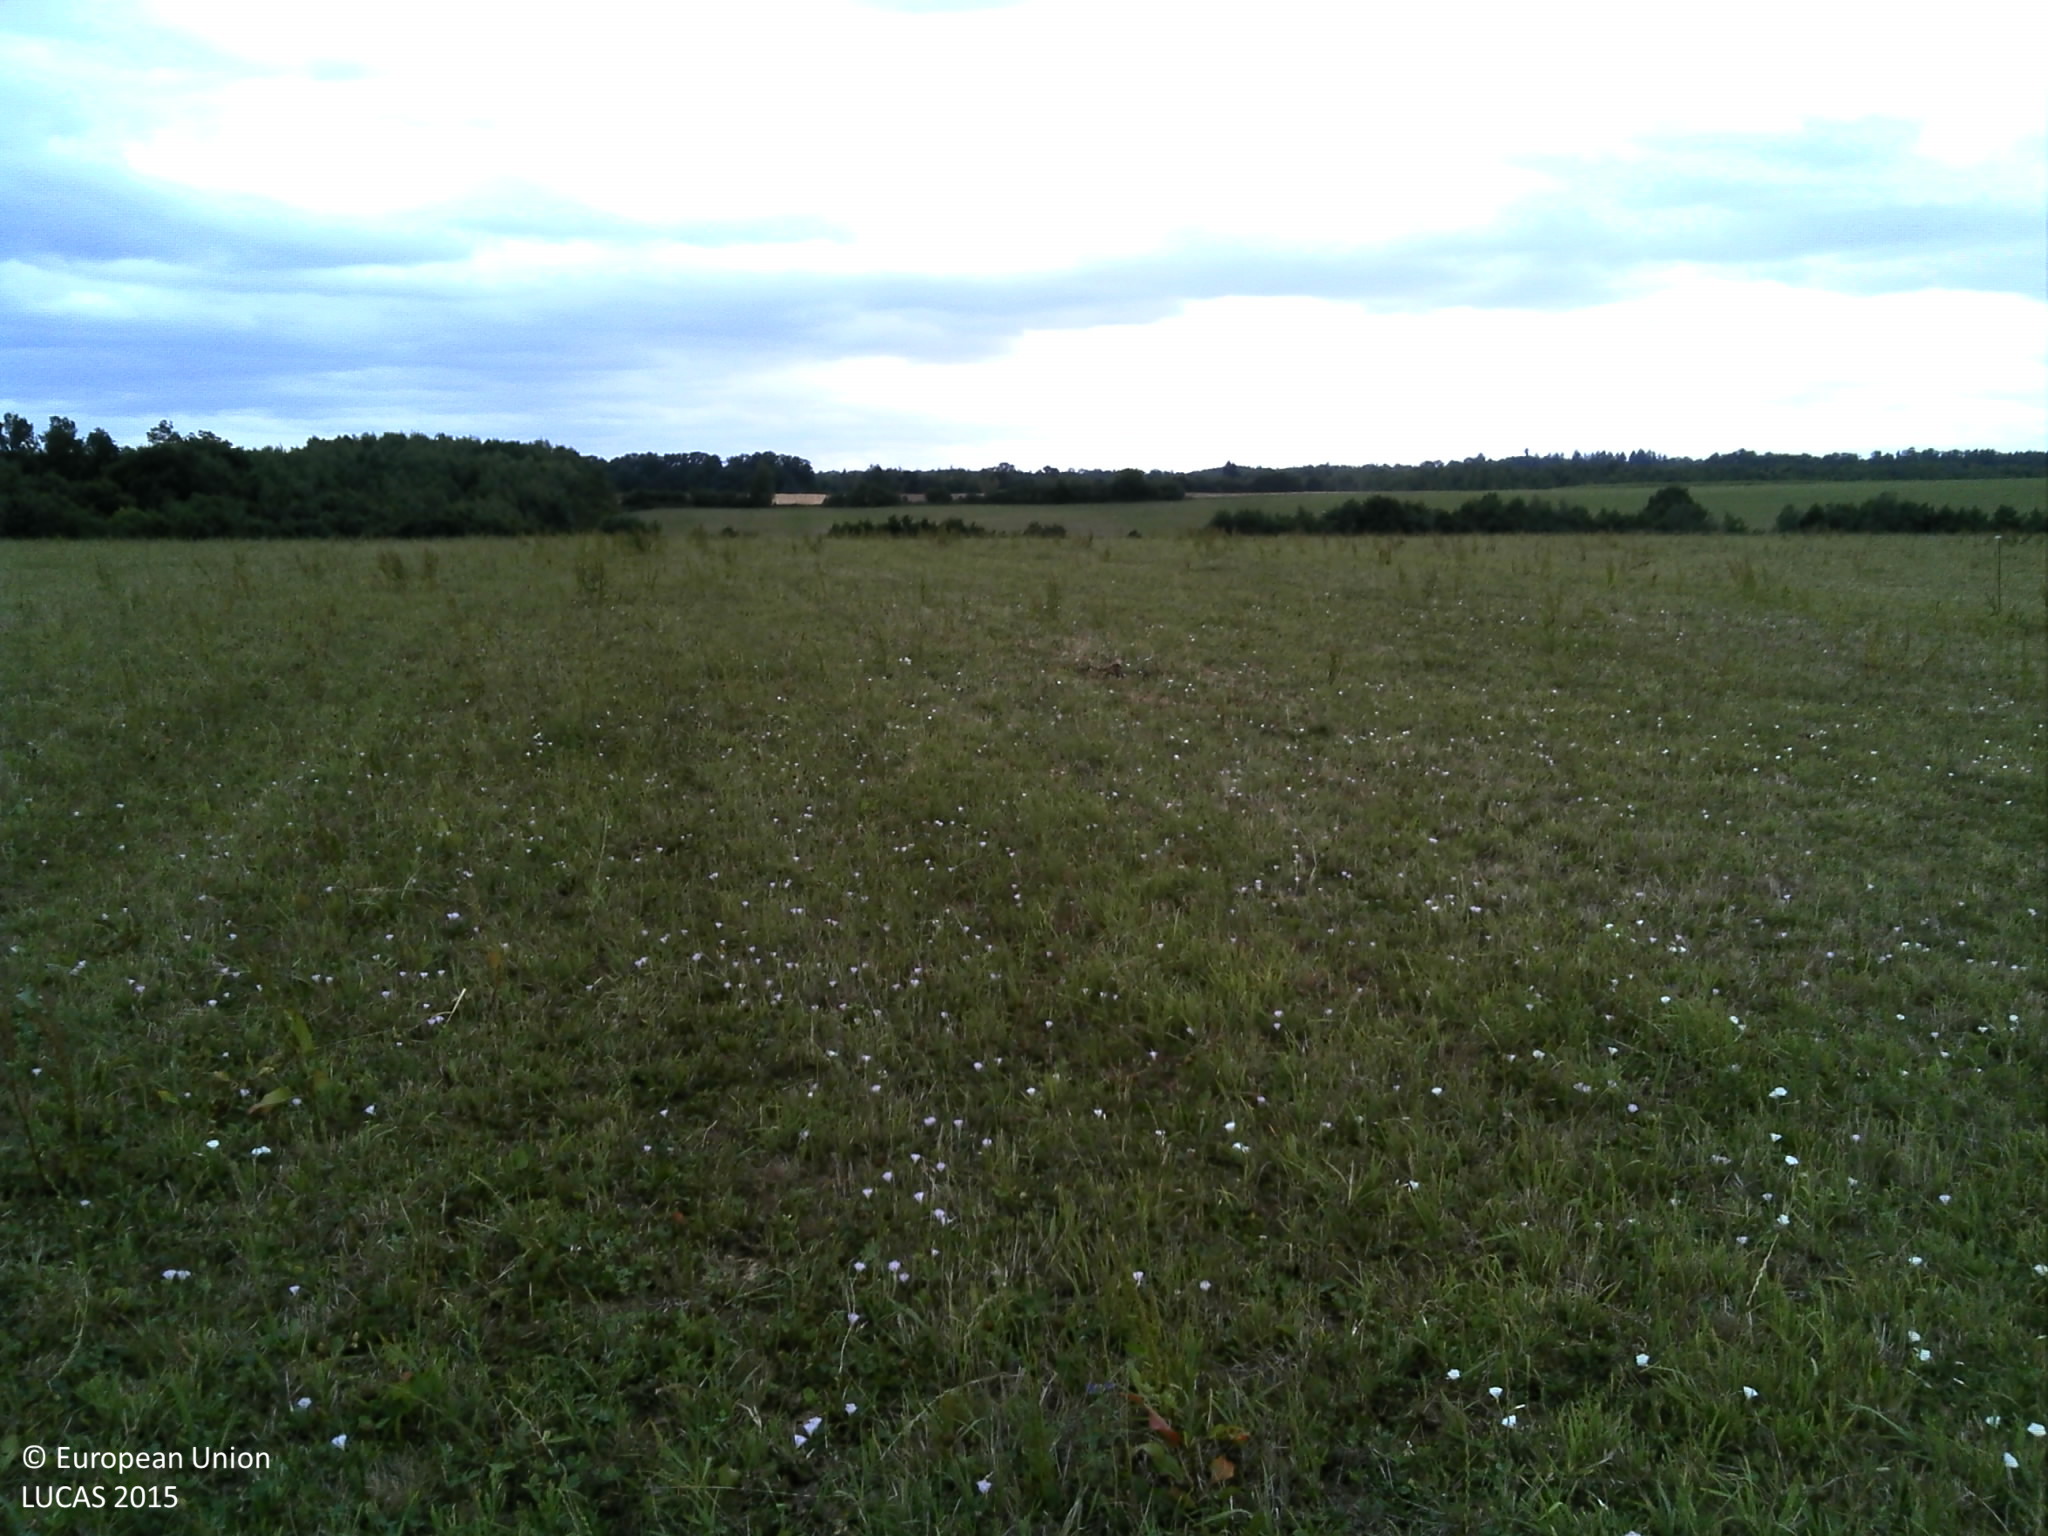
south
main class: Grassland
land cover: Grassland without tree/shrub cover
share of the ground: > 75 %
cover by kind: herbaceous plants 100 %
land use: Agriculture (excluding fallow land and kitchen gardens)
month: July
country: FR
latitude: 49.2221
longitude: 4.8761
